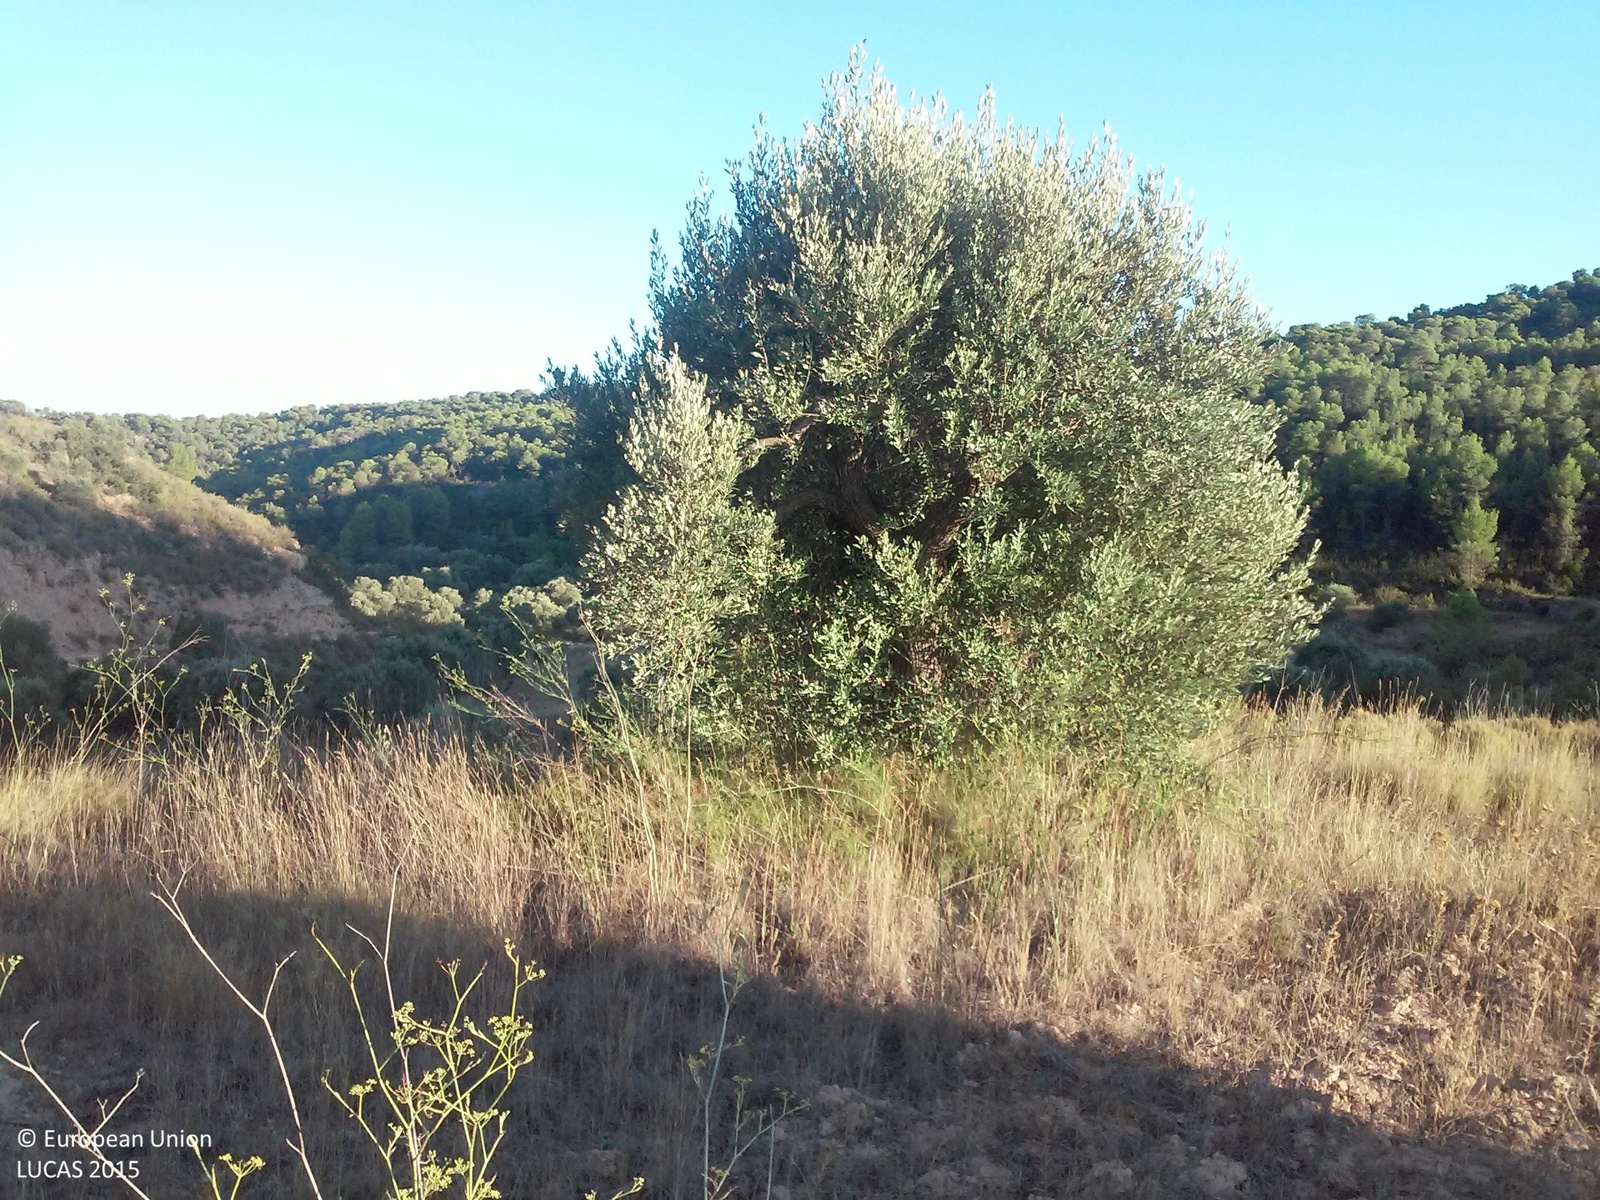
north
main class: Cropland
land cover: Olive groves
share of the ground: 10 - 25 %
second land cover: Grassland without tree/shrub cover
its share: > 75 %
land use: Agriculture (excluding fallow land and kitchen gardens)
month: August
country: ES
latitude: 41.2815
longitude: 0.5219
